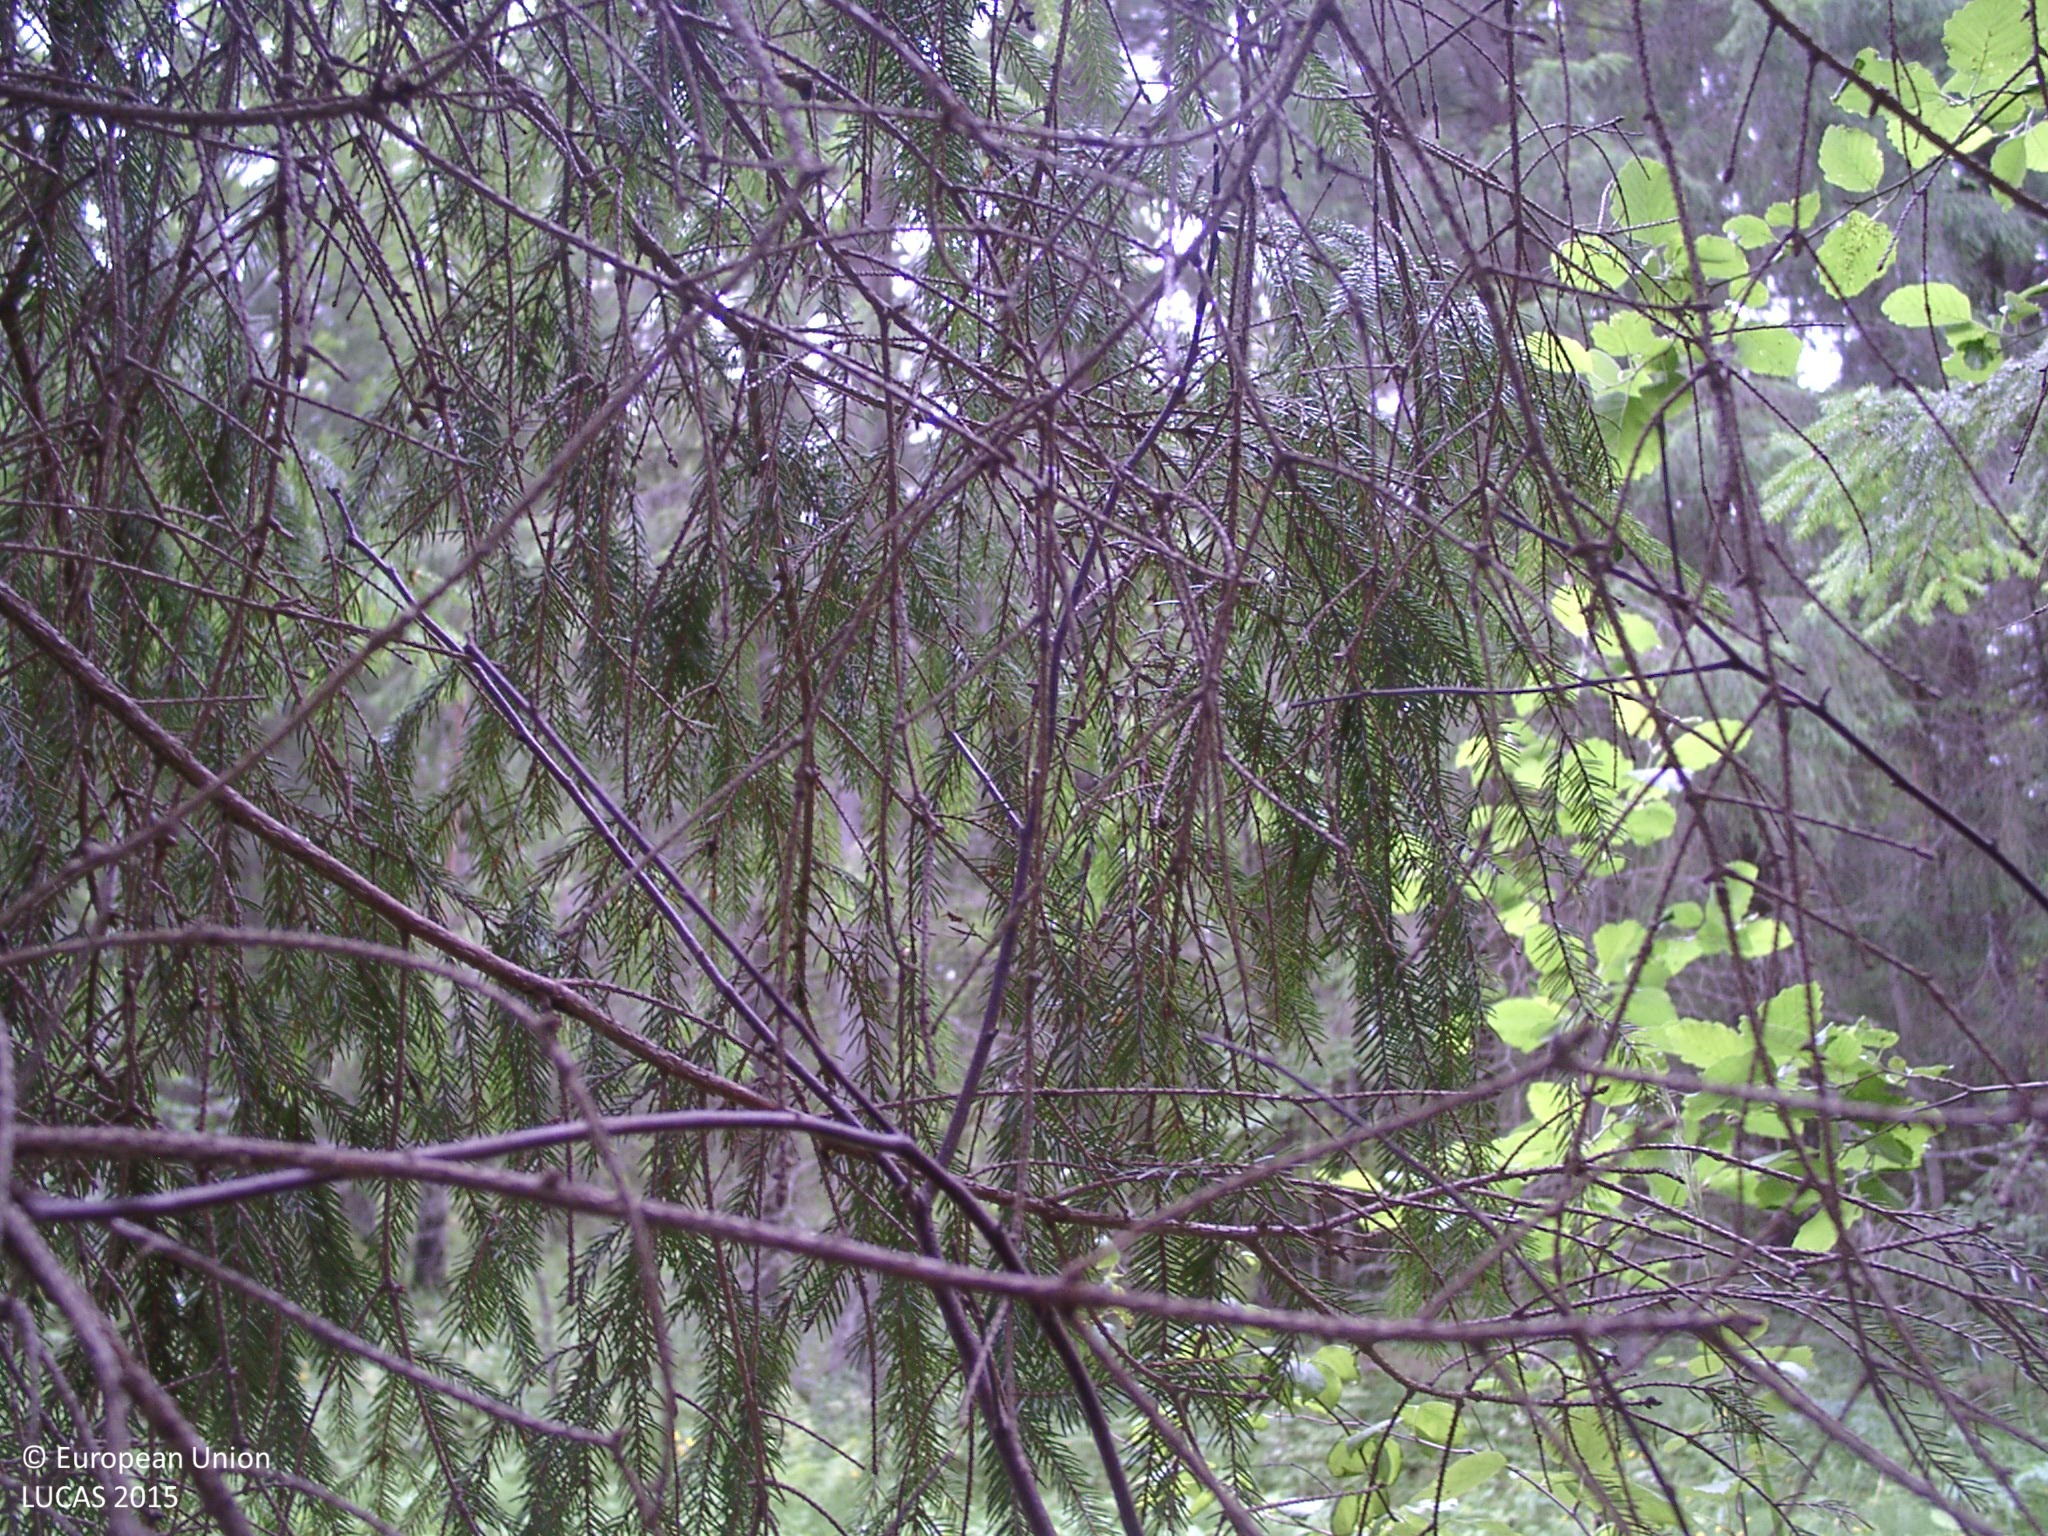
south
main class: Woodland
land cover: Spruce dominated coniferous woodland
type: boreal forest
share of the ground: 50 - 75 %
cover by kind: coniferous forest trees 55 %, broadleaved forest trees 15 %, herbaceous plants 15 %, shrubs 10 %, lichens and mosses 5 %
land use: Semi-natural and natural areas not in use
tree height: > 5 m
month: July
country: FI
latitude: 61.6813
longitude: 25.2498
